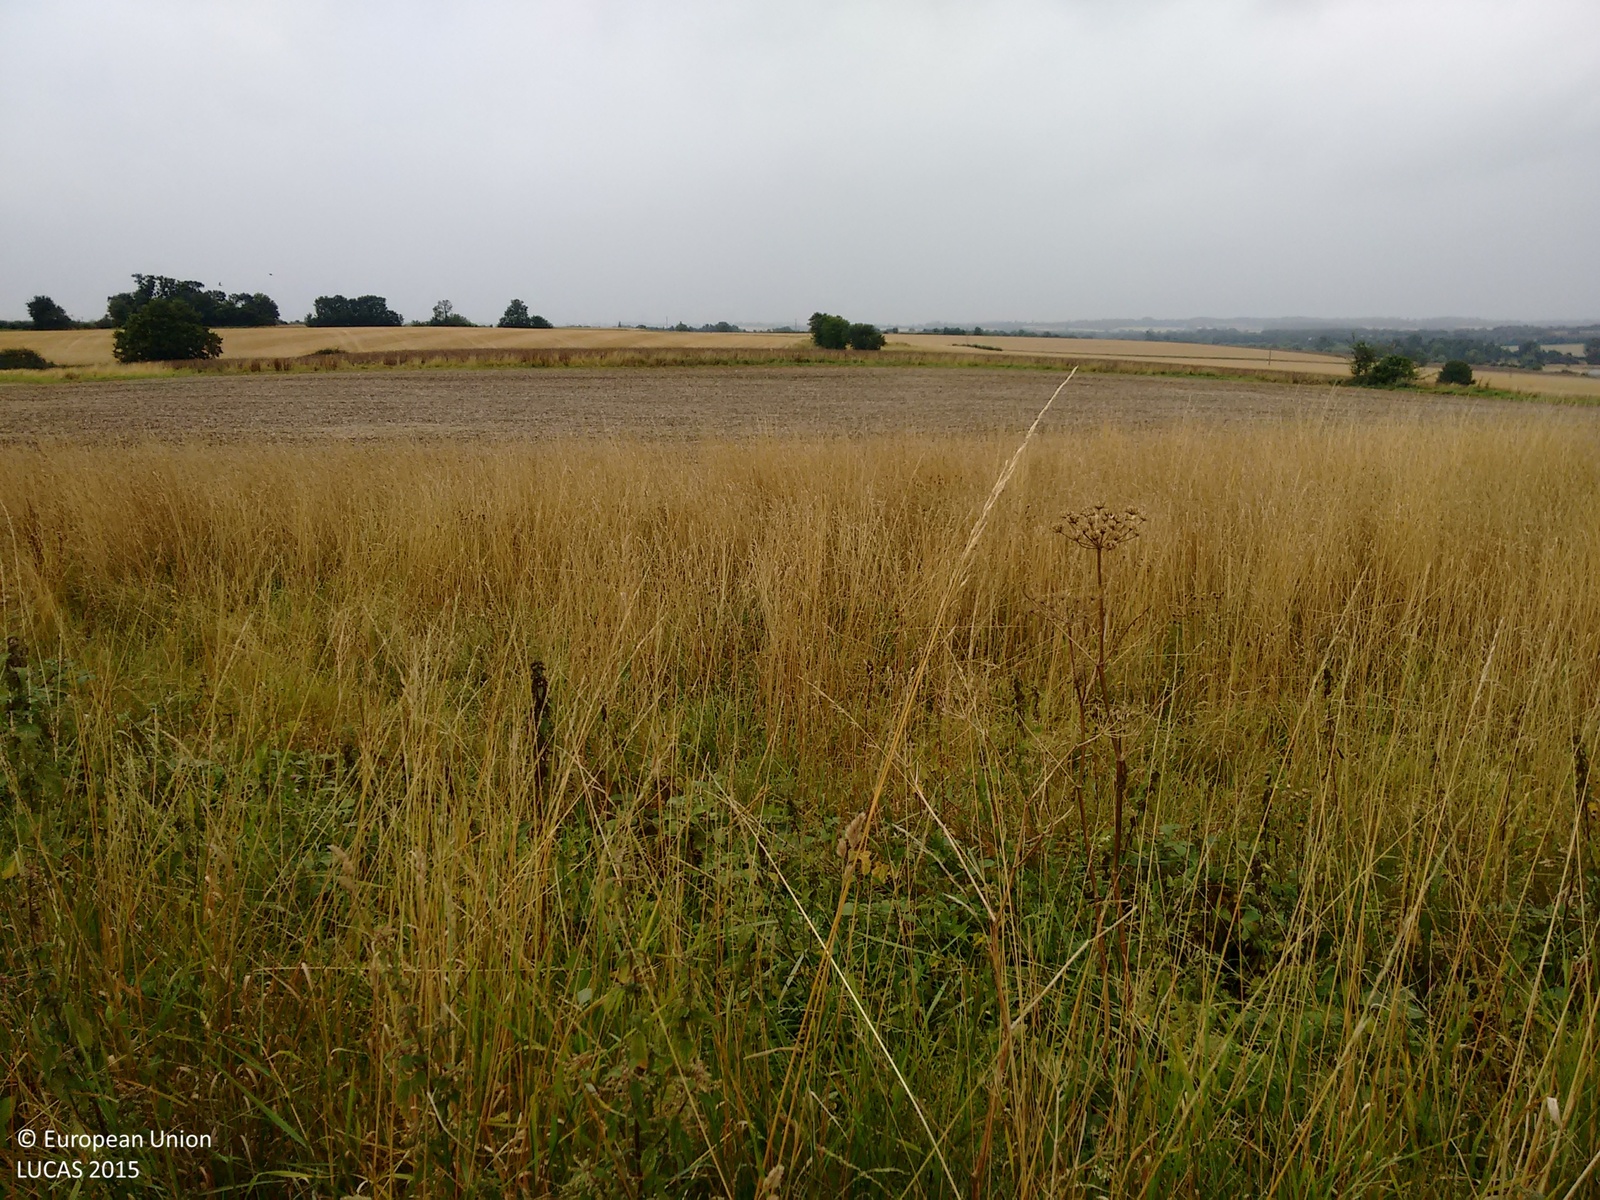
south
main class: Cropland
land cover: Dry pulses
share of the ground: > 75 %
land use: Agriculture (excluding fallow land and kitchen gardens)
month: August
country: GB
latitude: 52.0863
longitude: 0.5008
